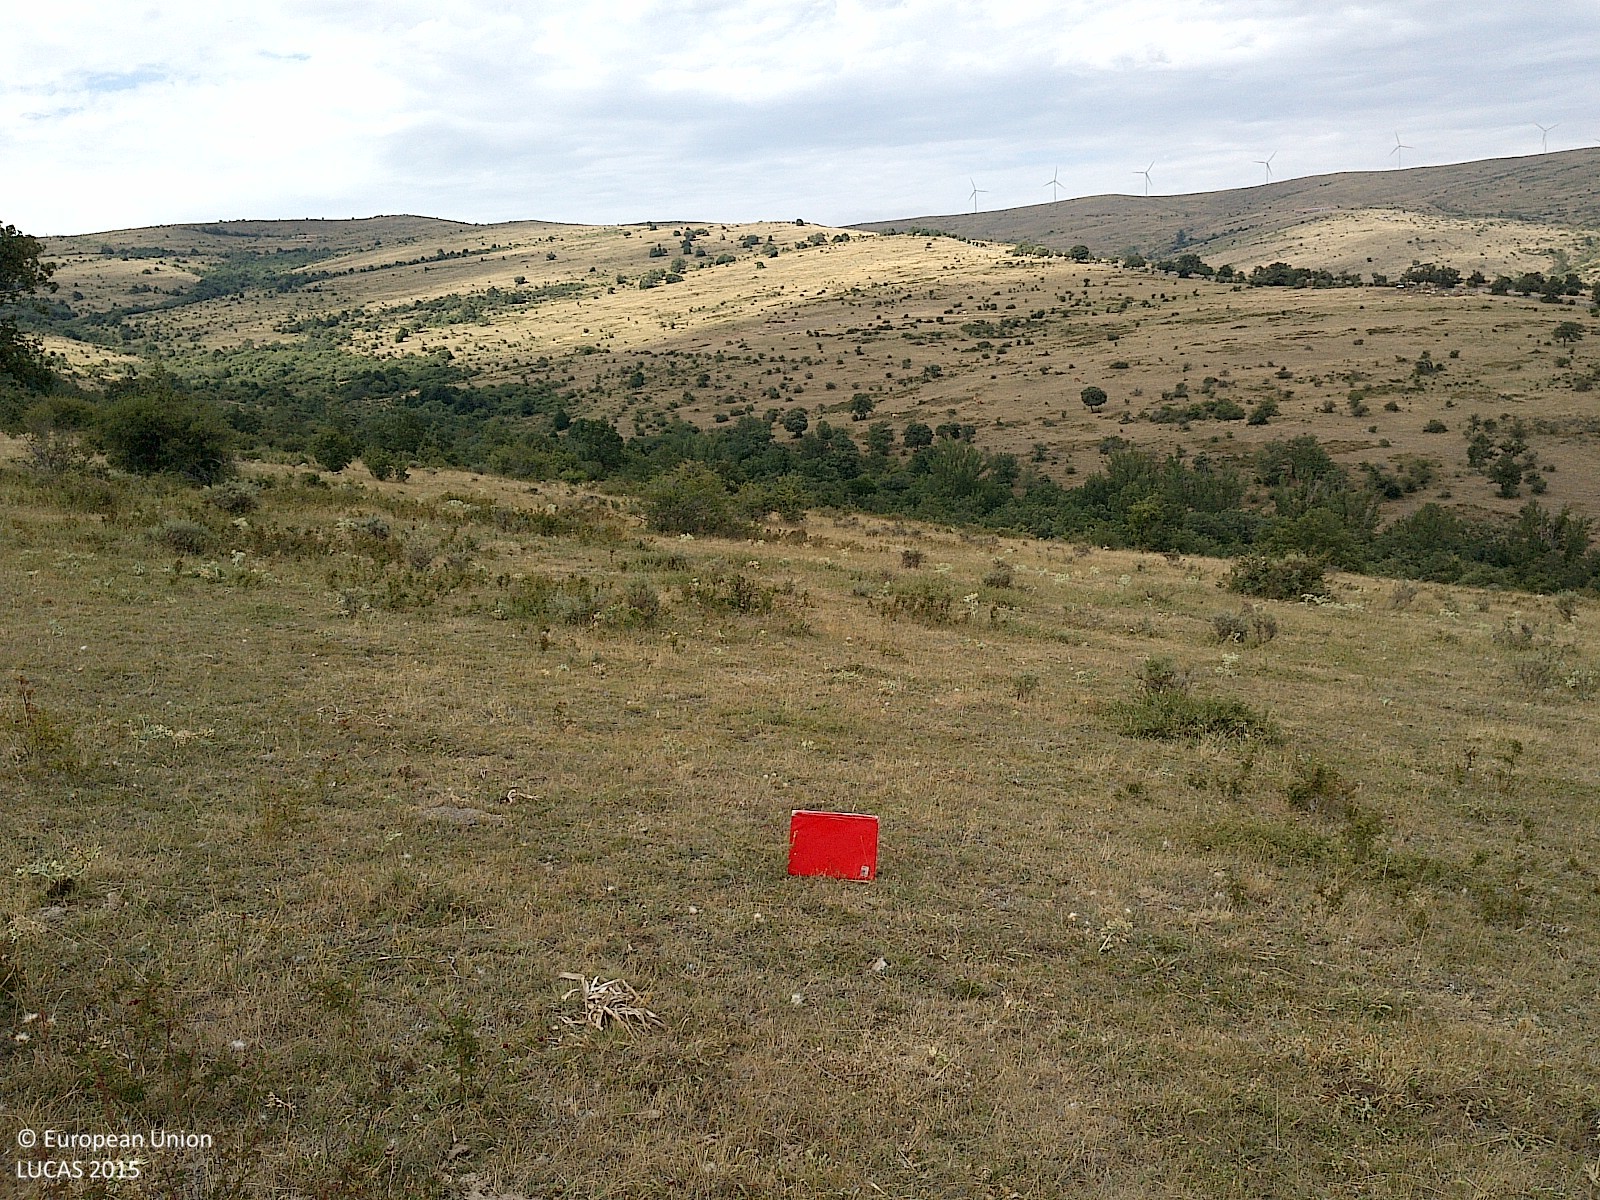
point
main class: Grassland
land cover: Grassland without tree/shrub cover
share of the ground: > 75 %
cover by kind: herbaceous plants 95 %, shrubs 5 %
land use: Agriculture (excluding fallow land and kitchen gardens)
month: July
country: ES
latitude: 41.9344
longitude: -2.3277
